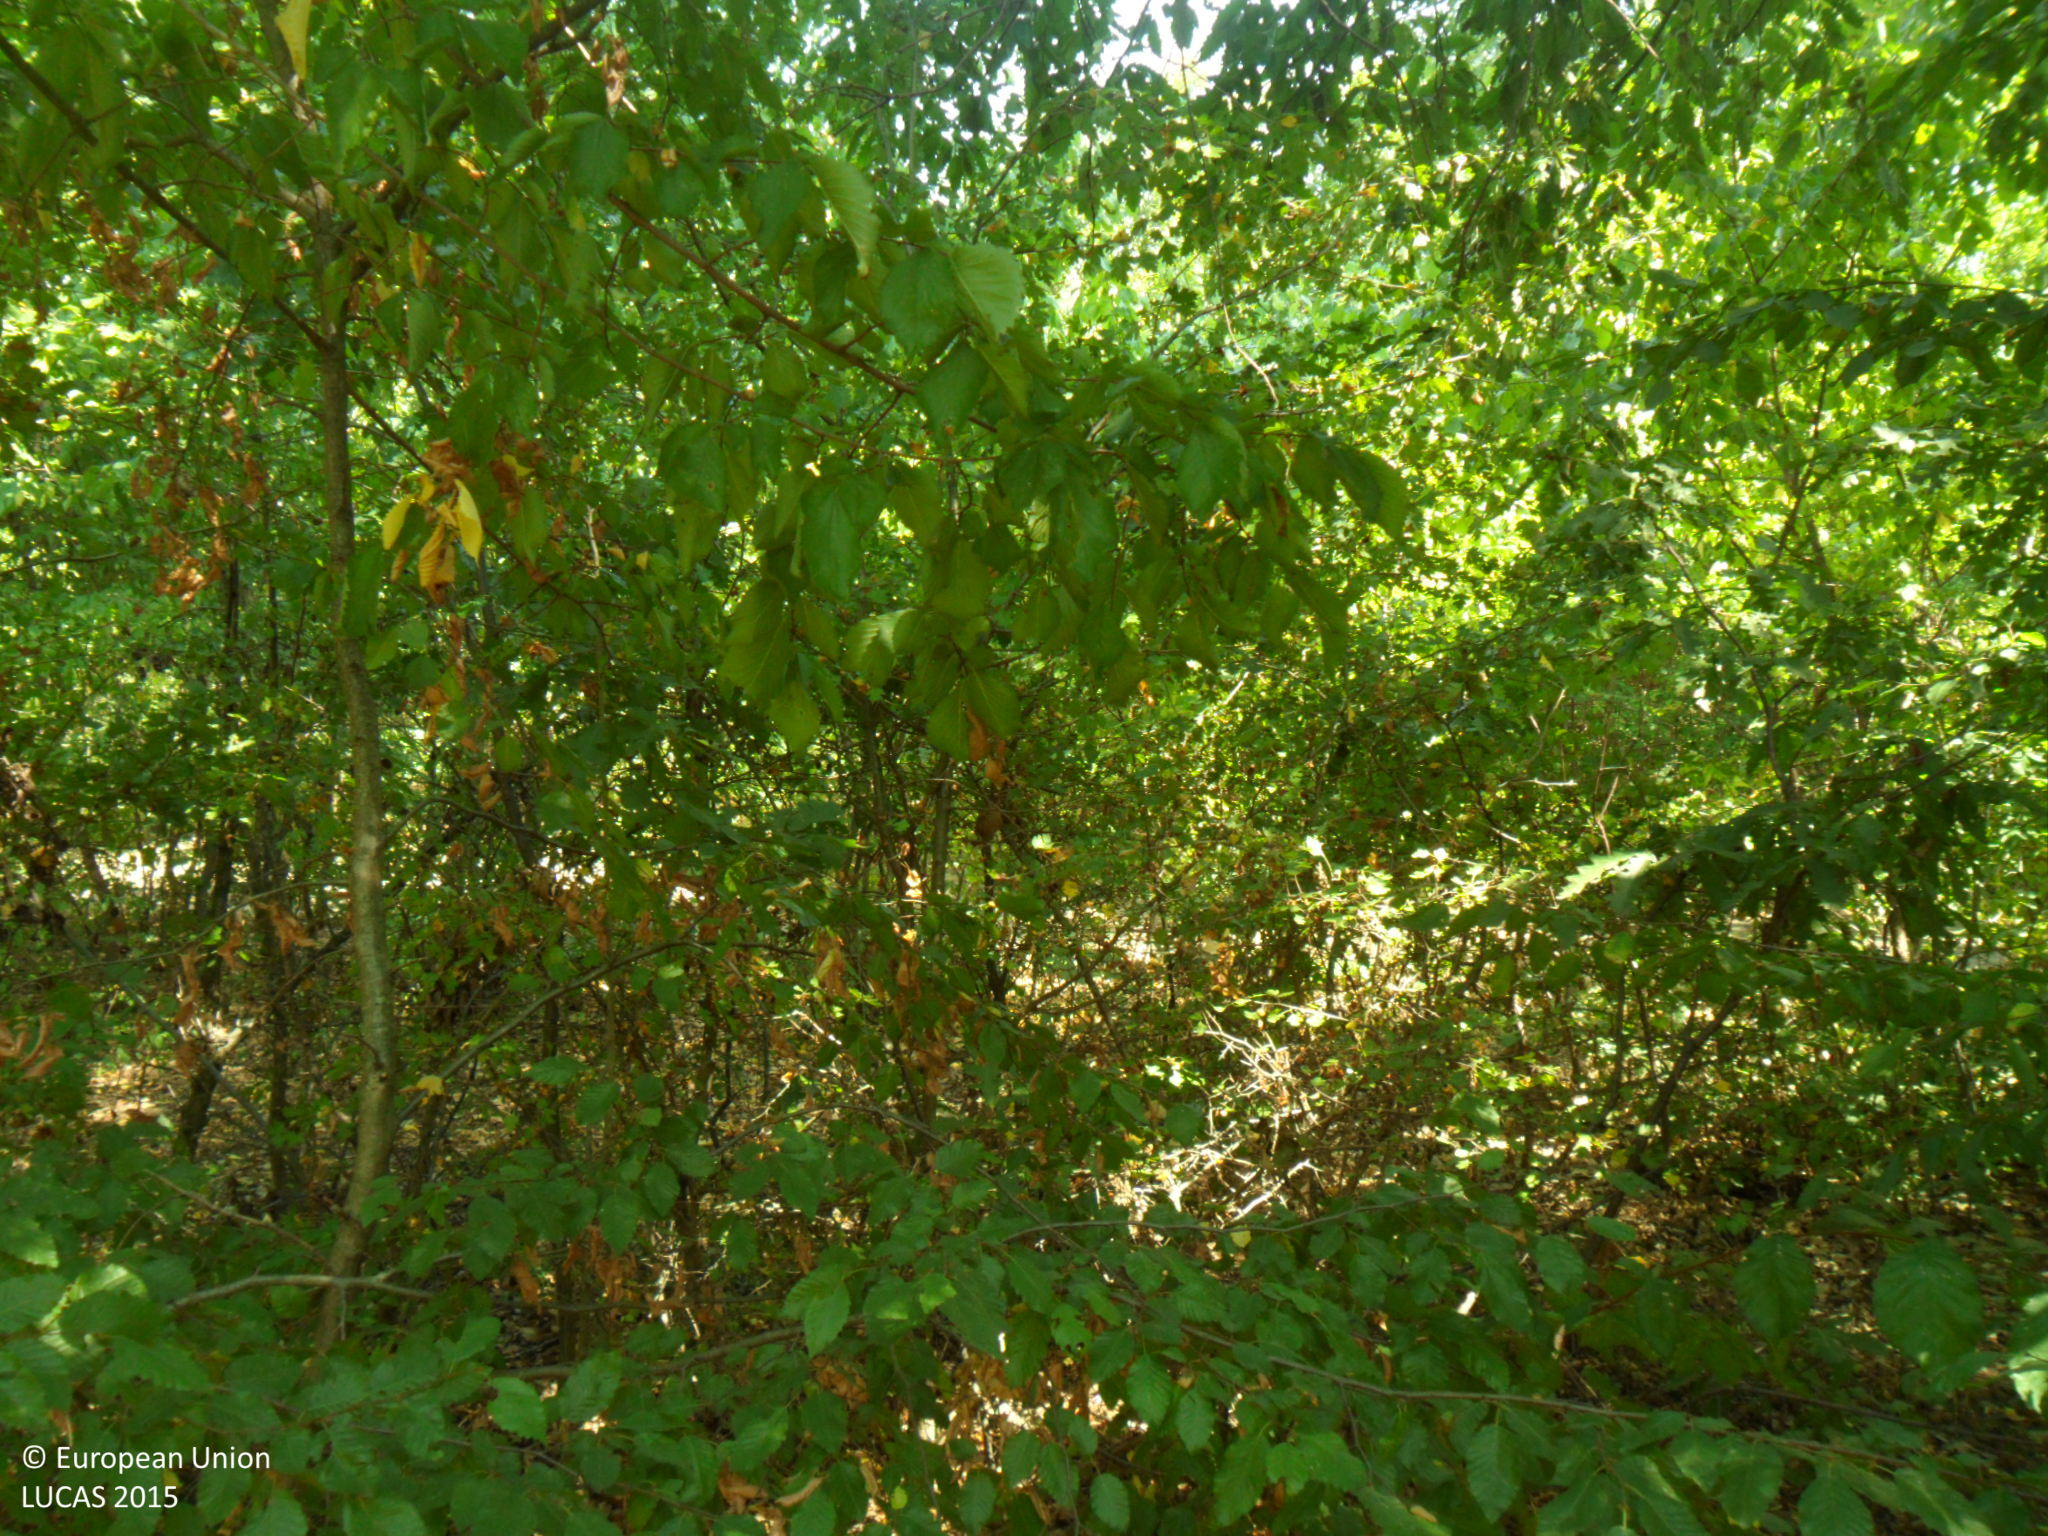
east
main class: Woodland
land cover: Broadleaved woodland
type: beech forest
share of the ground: > 75 %
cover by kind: broadleaved forest trees 90 %, herbaceous plants 10 %
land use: Forestry
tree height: > 5 m
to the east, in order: Broadleaved woodland; Tracks; Broadleaved woodland; Tracks; Broadleaved woodland; Tracks; Broadleaved woodland
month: August
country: BG
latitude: 43.5985
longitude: 27.1048
